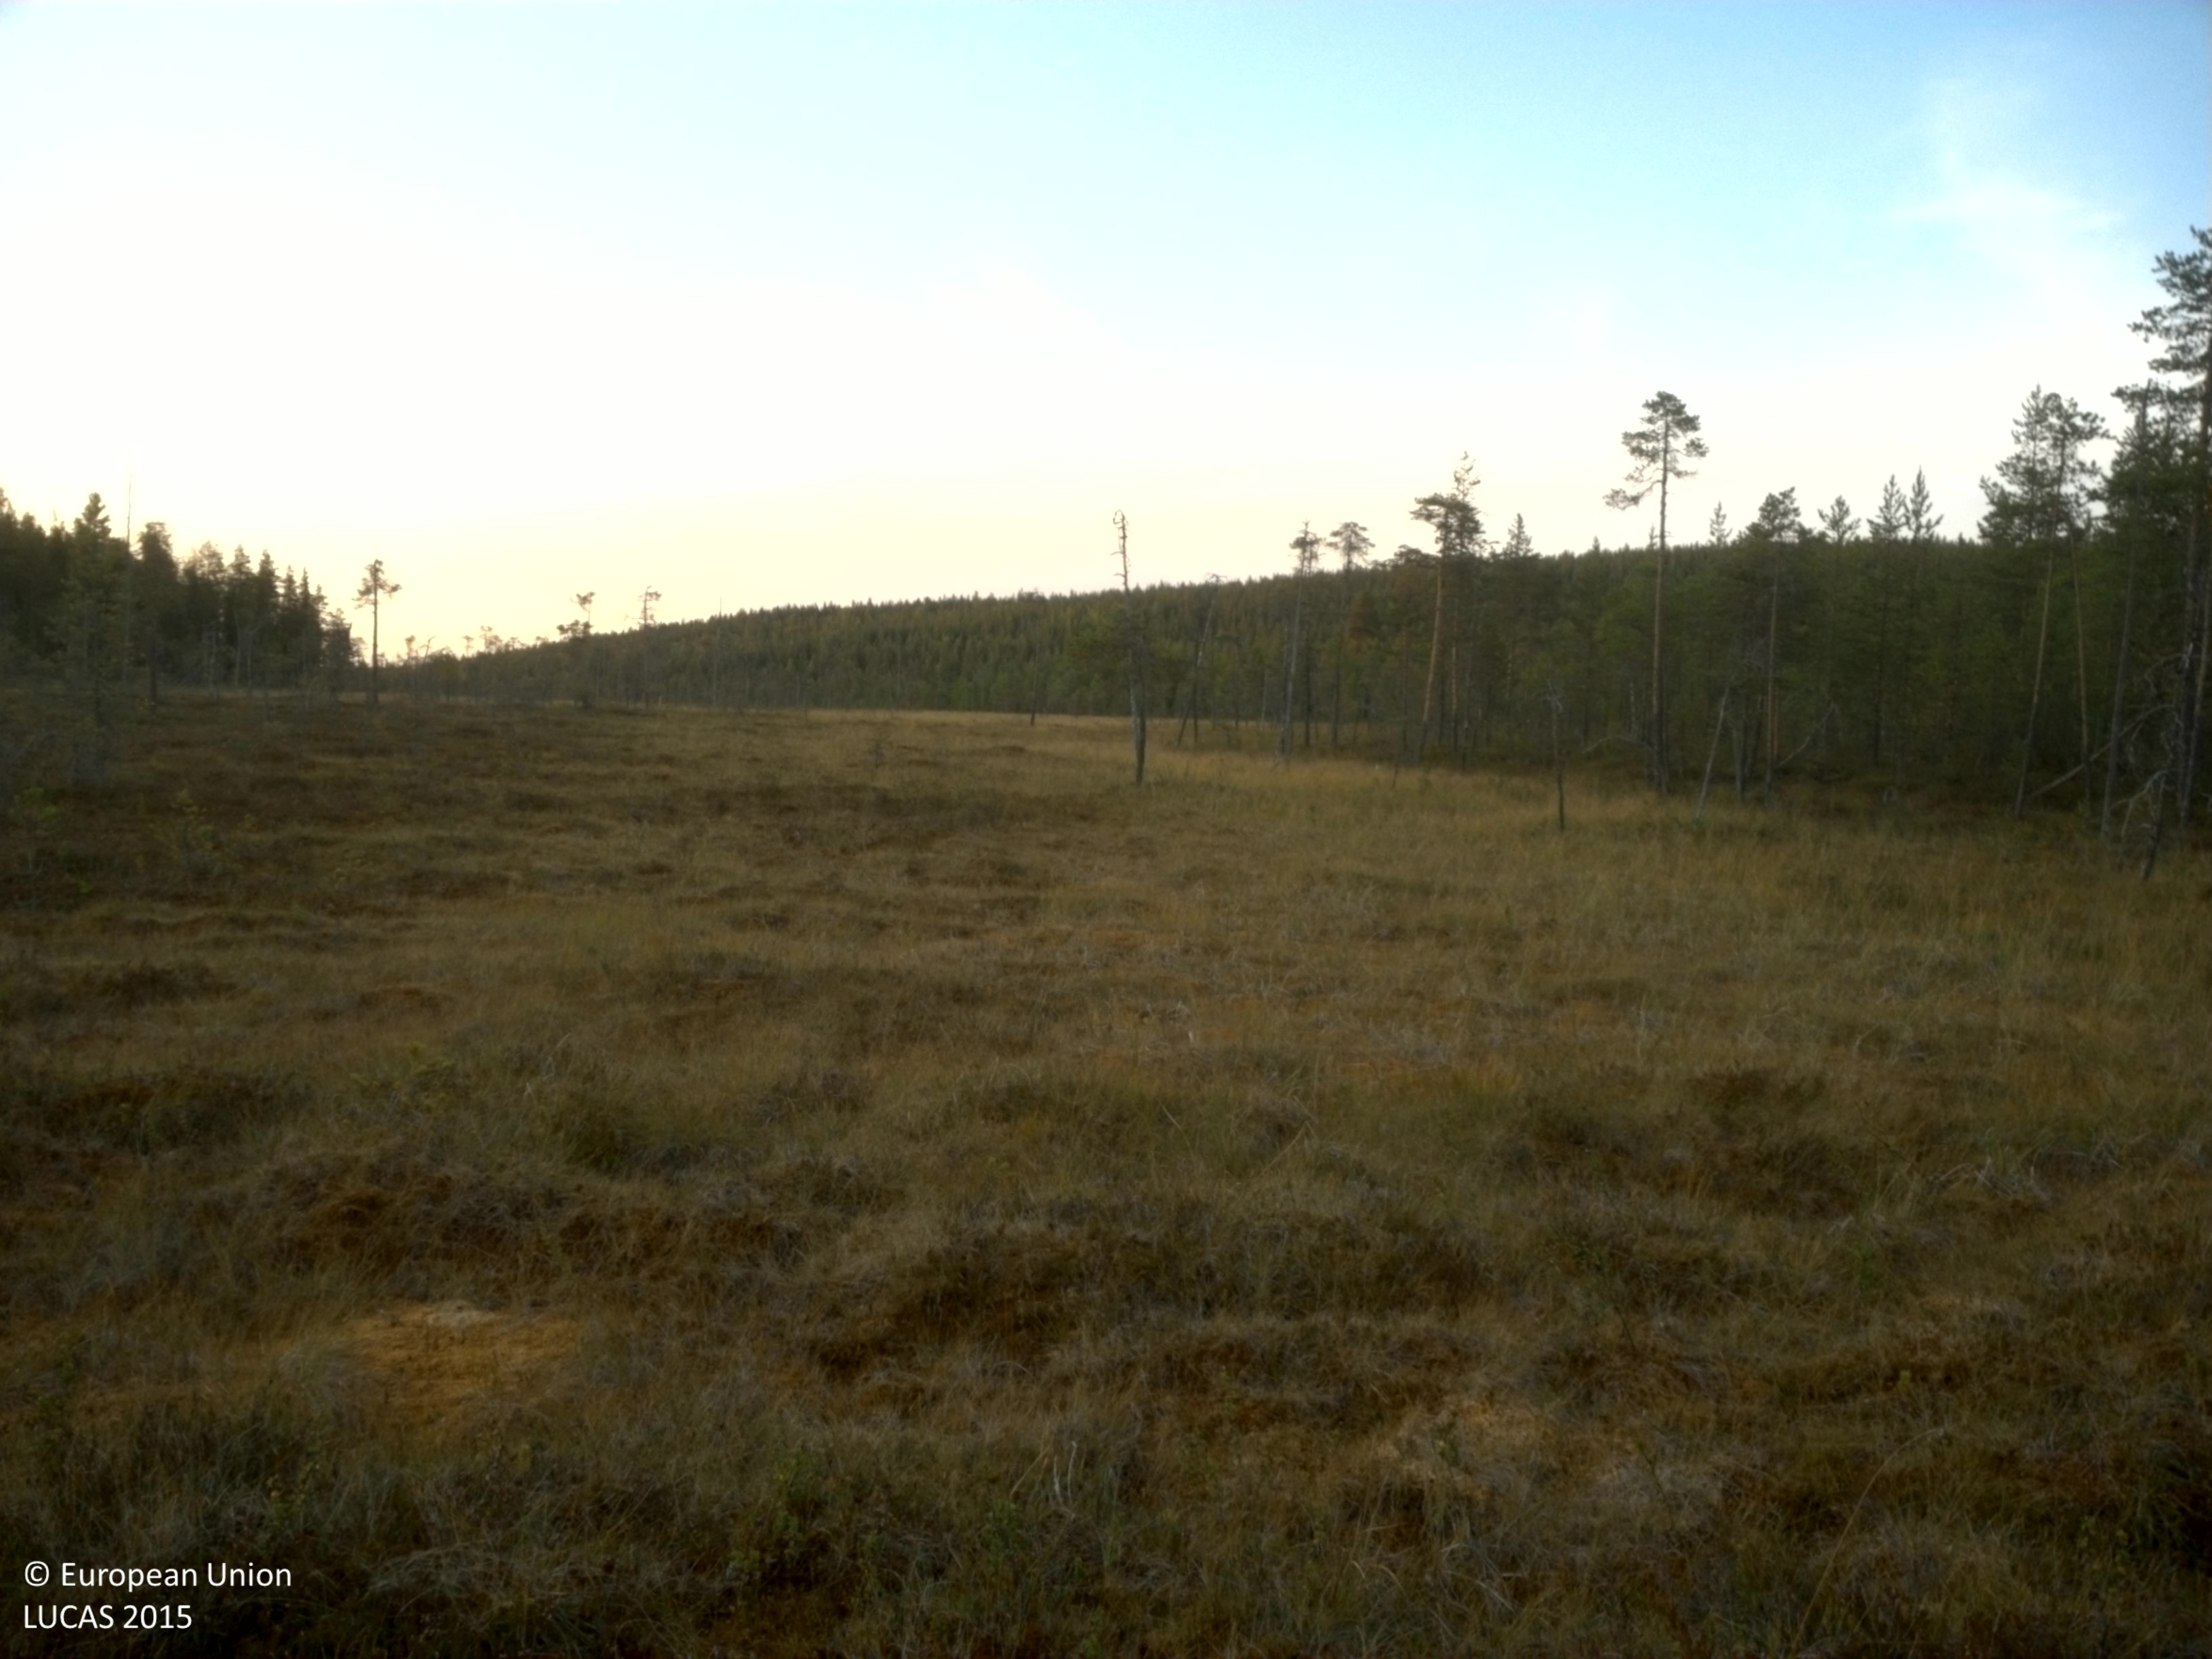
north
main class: Shrubland
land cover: Shrubland with sparse tree cover
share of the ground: > 75 %
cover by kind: shrubs 75 %, herbaceous plants 10 %, lichens and mosses 10 %, coniferous forest trees 5 %
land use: Semi-natural and natural areas not in use
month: August
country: SE
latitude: 64.4891
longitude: 18.9806
